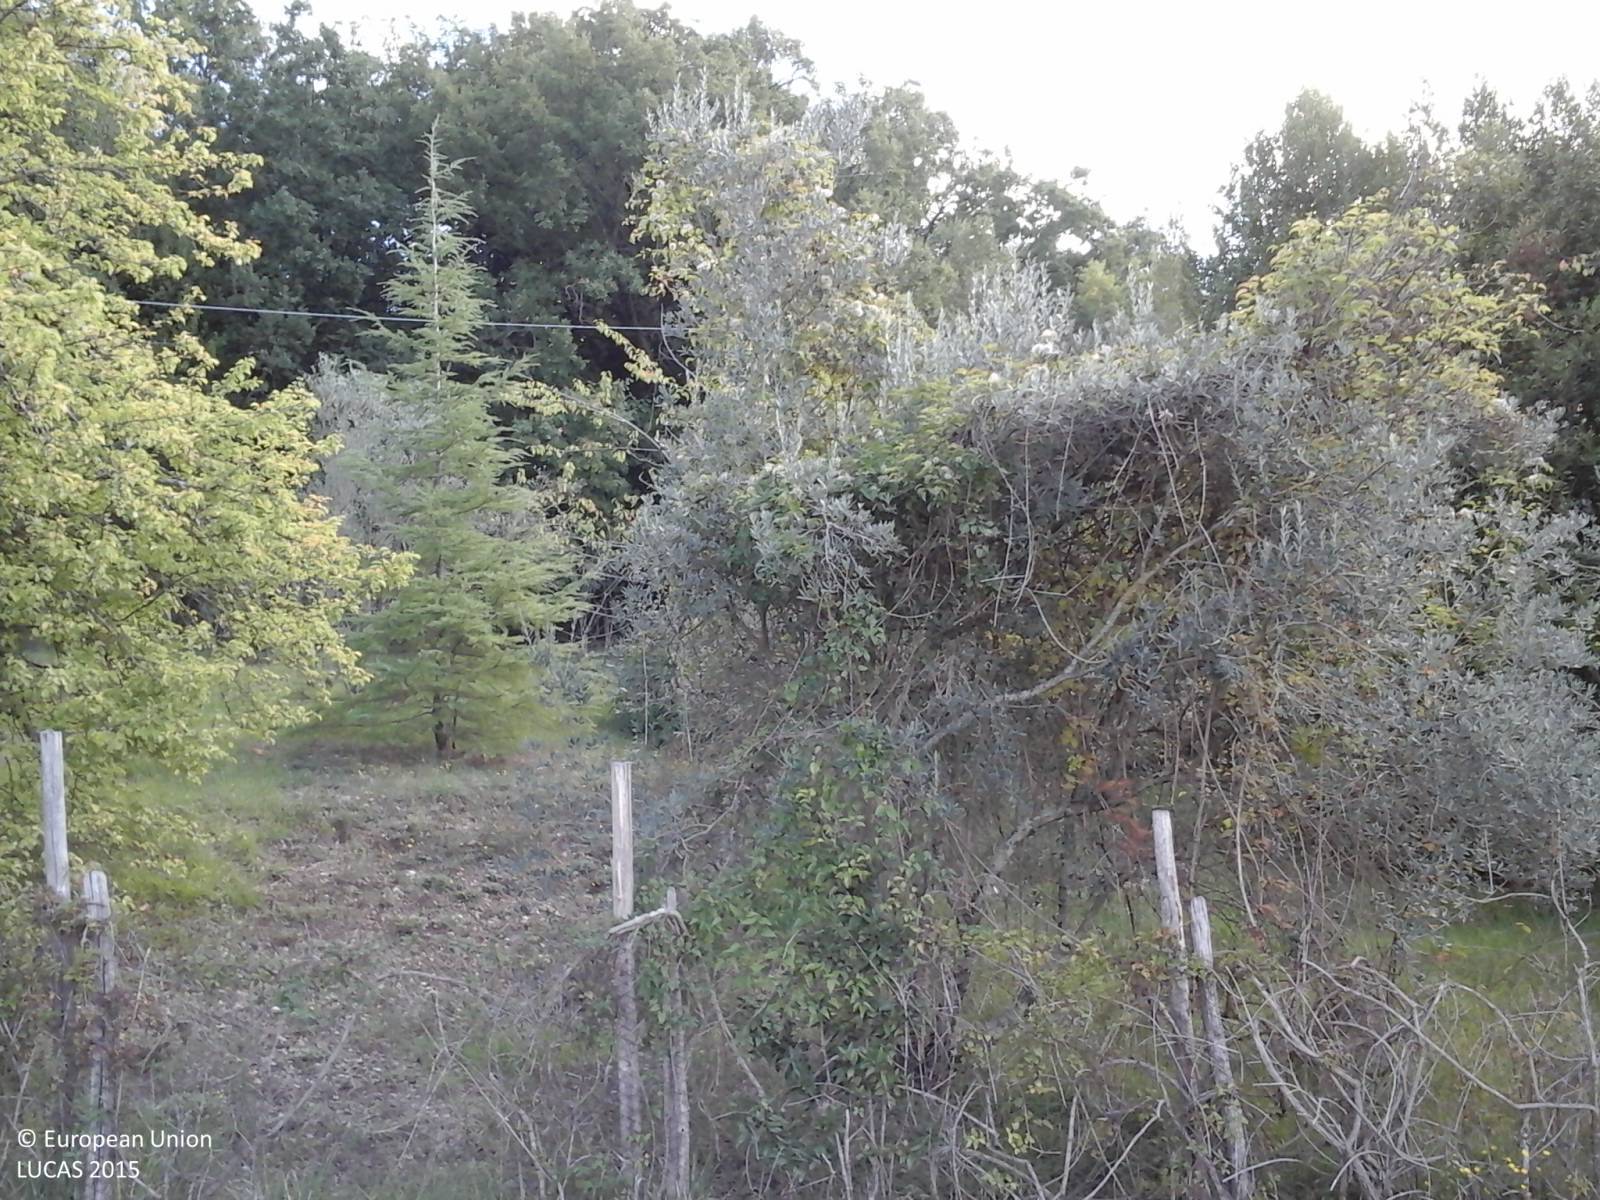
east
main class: Woodland
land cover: Broadleaved woodland
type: thermophilous deciduous forest
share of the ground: > 75 %
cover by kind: broadleaved forest trees 95 %, shrubs 5 %
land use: Forestry
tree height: > 5 m
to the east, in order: Broadleaved woodland; Grassland without tree/shrub cover; Broadleaved woodland
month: October
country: IT
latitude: 42.4326
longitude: 12.8714
